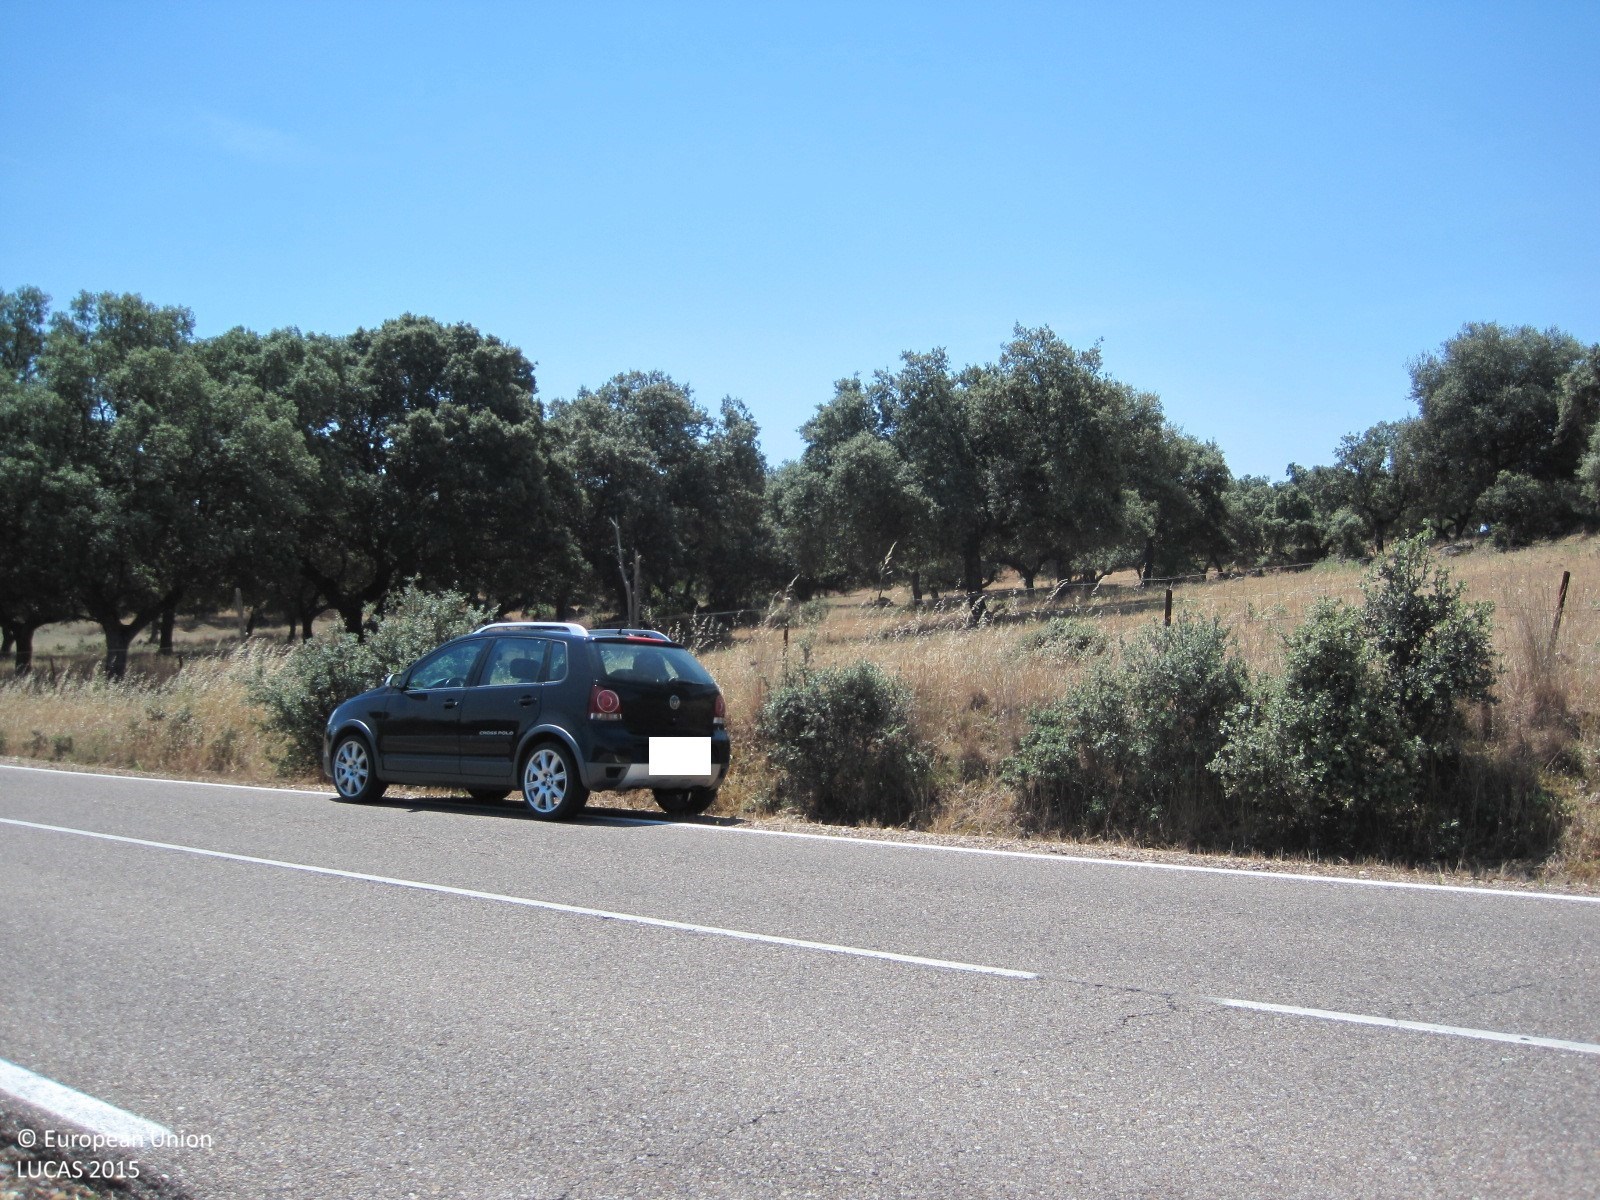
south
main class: Woodland
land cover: Broadleaved woodland
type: broadleaved evergreen forest
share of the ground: 50 - 75 %
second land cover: Grassland without tree/shrub cover
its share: > 75 %
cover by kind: broadleaved forest trees 45 %, herbaceous plants 45 %, unconsolidated bare surface 10 %
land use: Forestry
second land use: Agriculture (excluding fallow land and kitchen gardens)
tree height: < 5 m
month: June
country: ES
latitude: 40.0404
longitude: -4.7804
